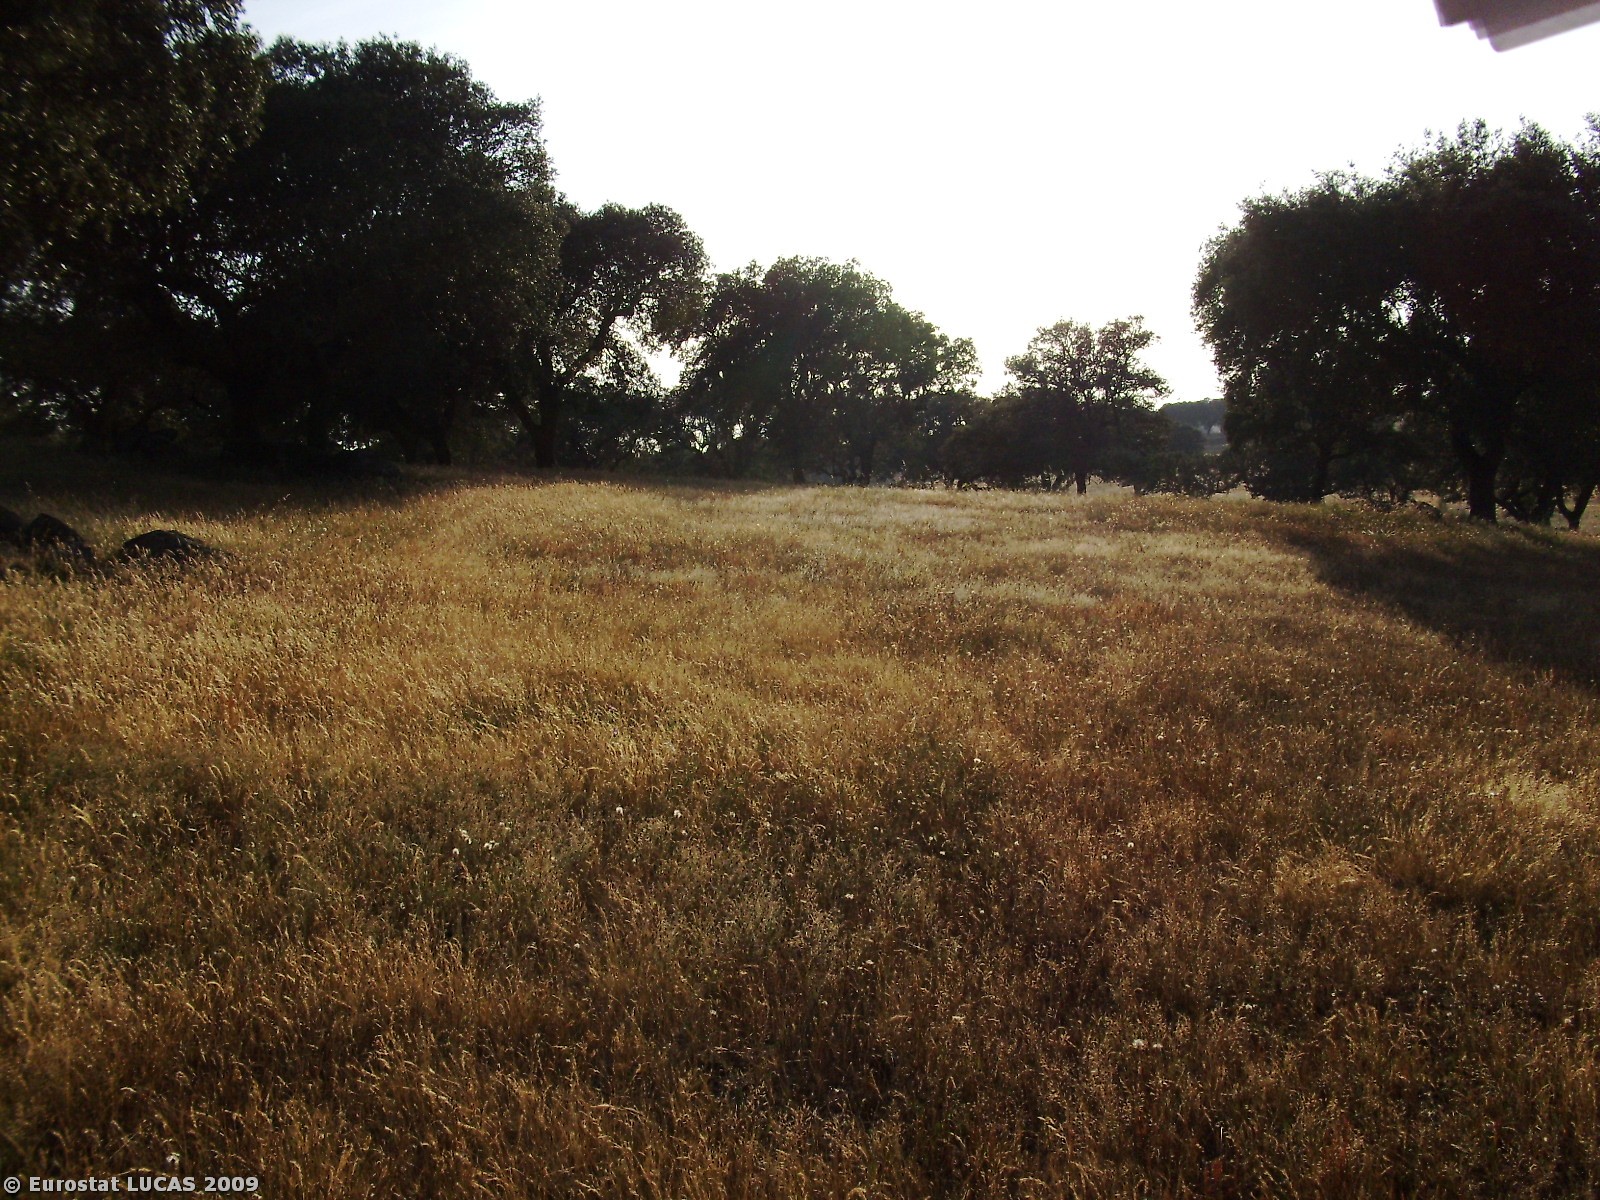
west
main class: Woodland
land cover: Broadleaved woodland
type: broadleaved evergreen forest
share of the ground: 25 - 50 %
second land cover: Grassland with sparse tree/shrub cover
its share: 50 - 75 %
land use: Forestry
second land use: Agriculture (excluding fallow land and kitchen gardens)
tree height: > 5 m
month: June
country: PT
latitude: 39.0316
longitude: -7.3984
